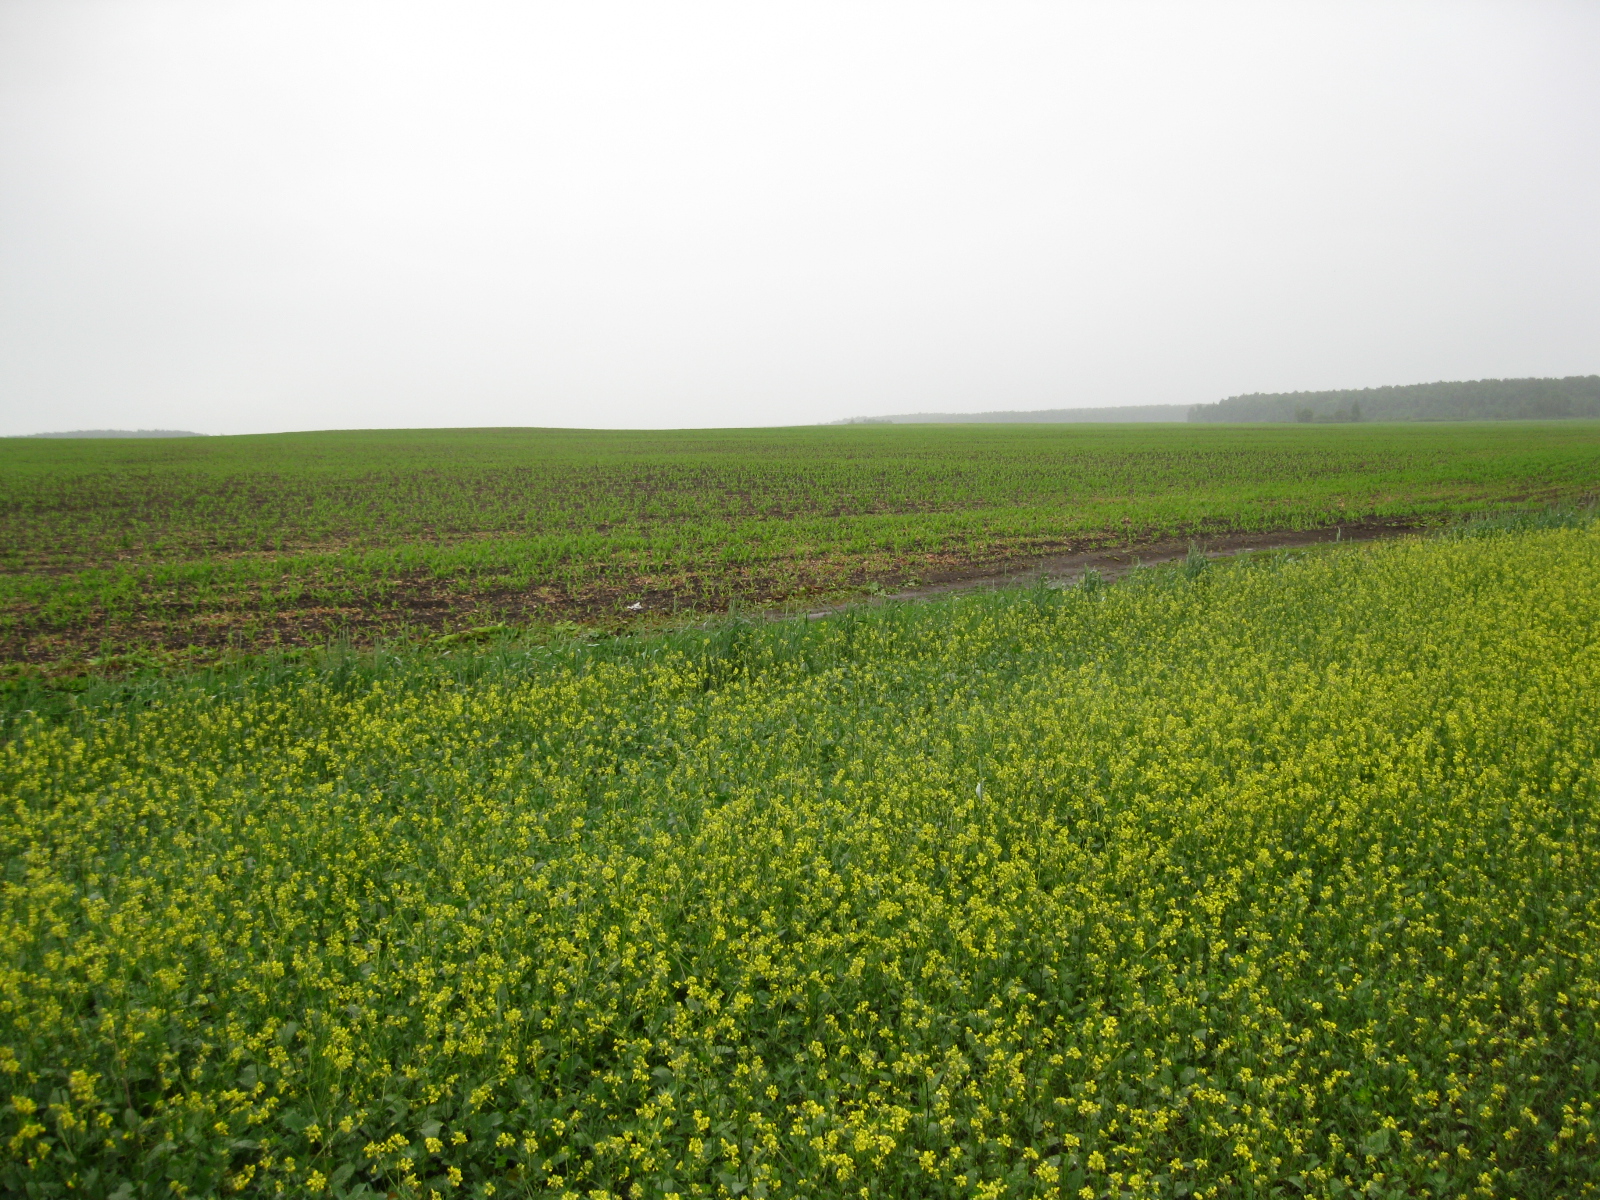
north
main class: Cropland
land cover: Rape and turnip rape
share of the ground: > 75 %
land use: Agriculture (excluding fallow land and kitchen gardens)
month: June
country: LT
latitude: 55.4878
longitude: 23.8385
